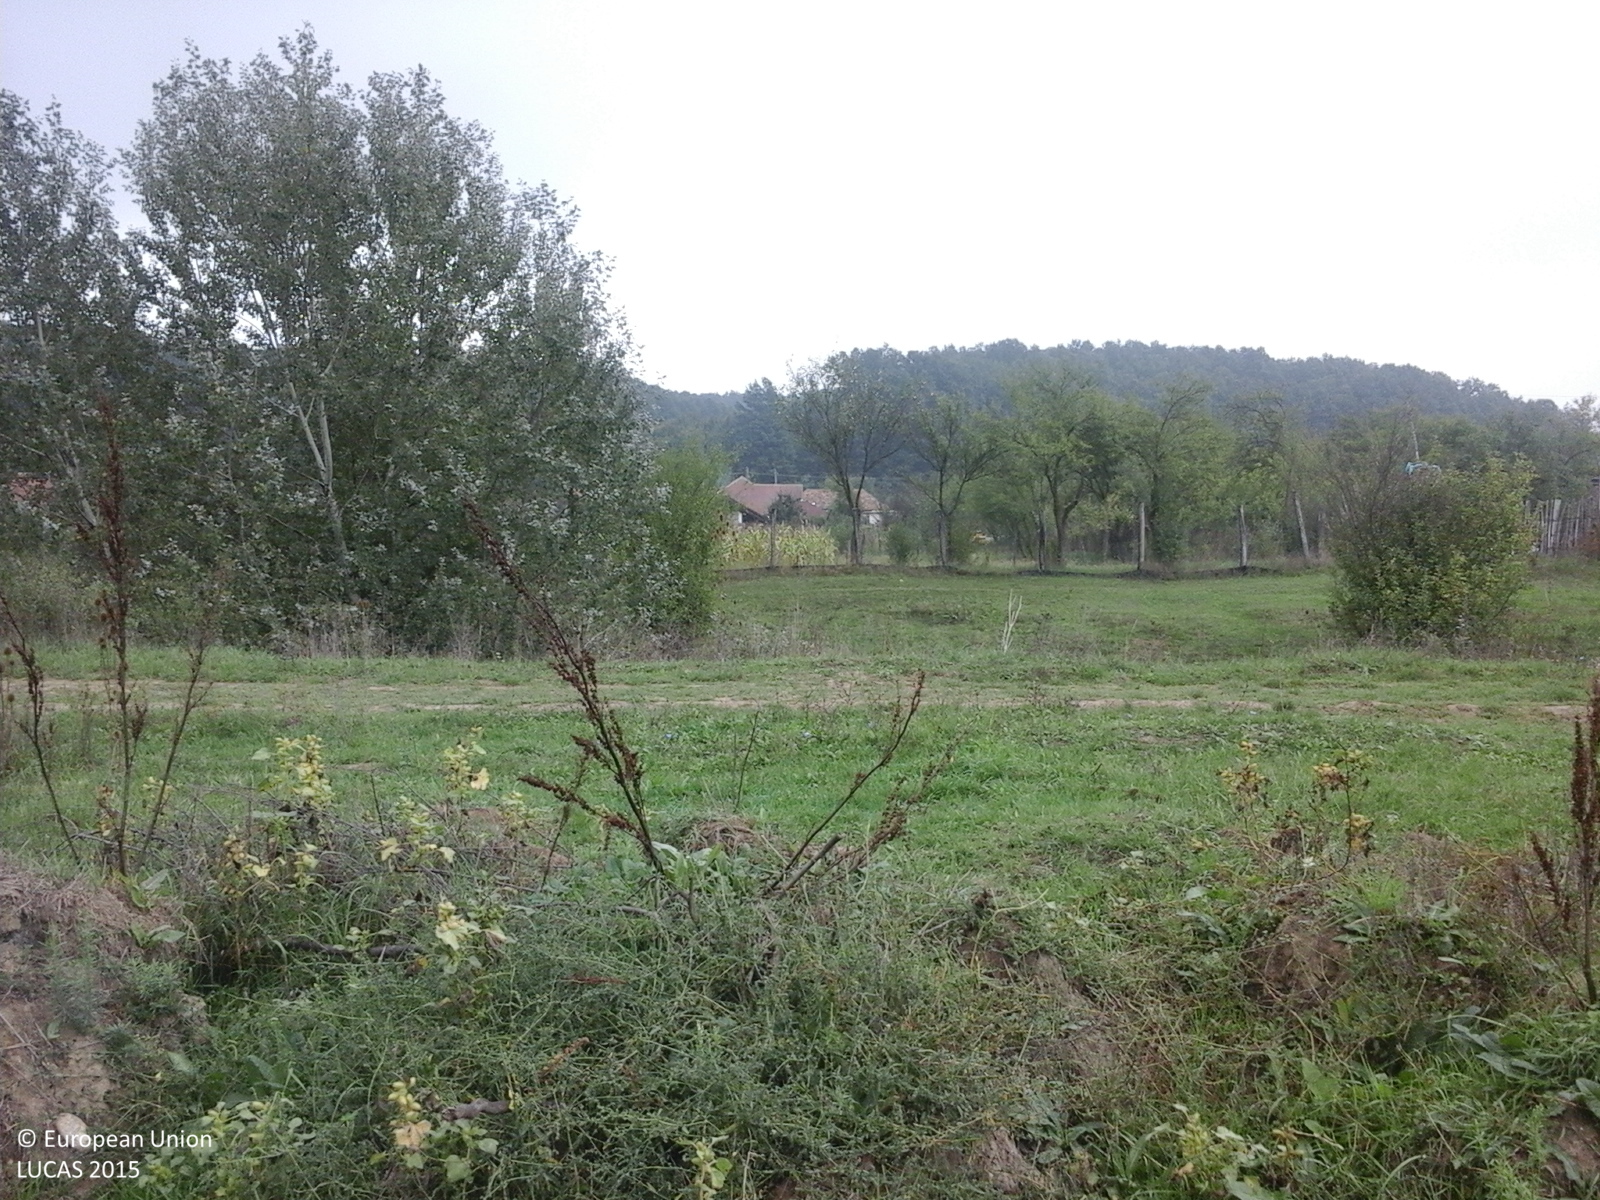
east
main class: Grassland
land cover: Spontaneously vegetated surfaces
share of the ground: > 75 %
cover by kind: herbaceous plants 100 %
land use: Fallow land
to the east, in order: Spontaneously vegetated surfaces; Grass margins; Tracks; Grass margins; Ditches and canals; Grassland with sparse tree/shrub cover; Grassland without tree/shrub cover; Fences; Lines of trees; Other fruit trees and berries; Maize; Arable land (only in case pi); Artificial constructions in urban areas; Vineyards; Fences; Broadleaved woodland
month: September
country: RO
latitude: 44.8531
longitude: 22.9156
